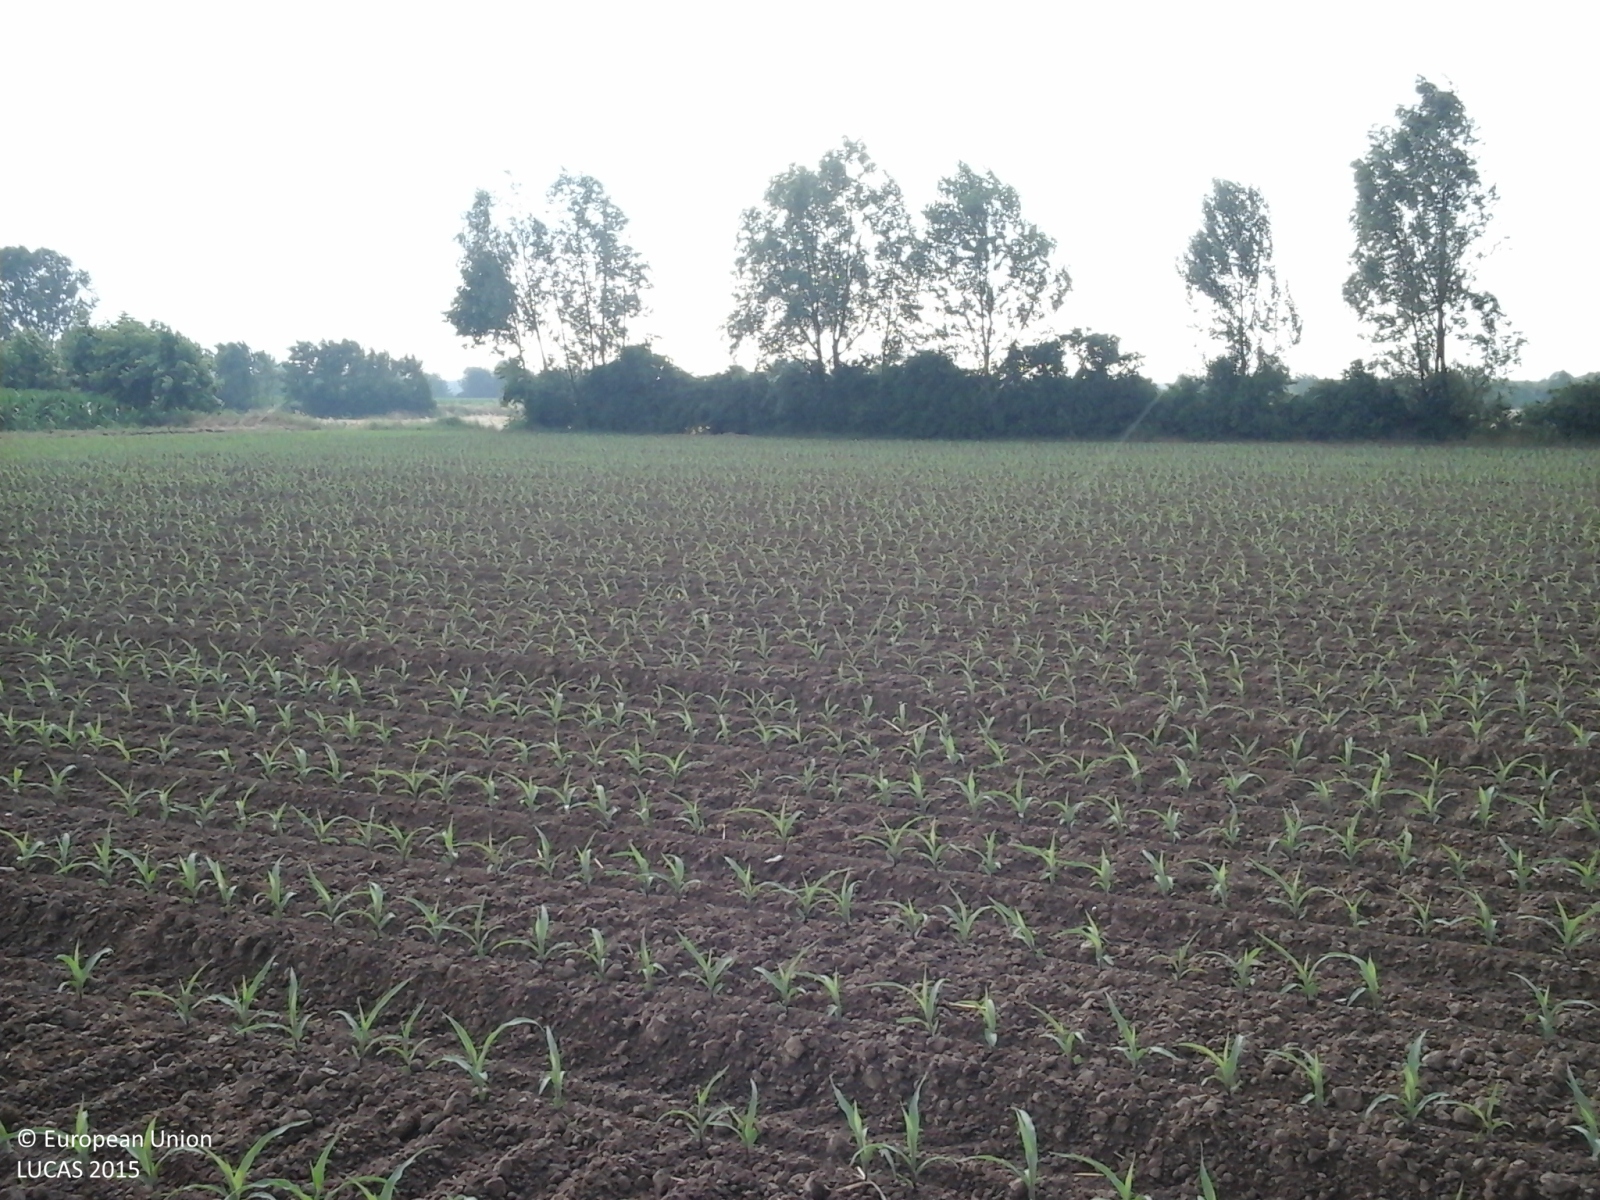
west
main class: Cropland
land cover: Maize
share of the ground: < 10 %
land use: Agriculture (excluding fallow land and kitchen gardens)
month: June
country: IT
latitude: 45.4862
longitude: 10.1660
